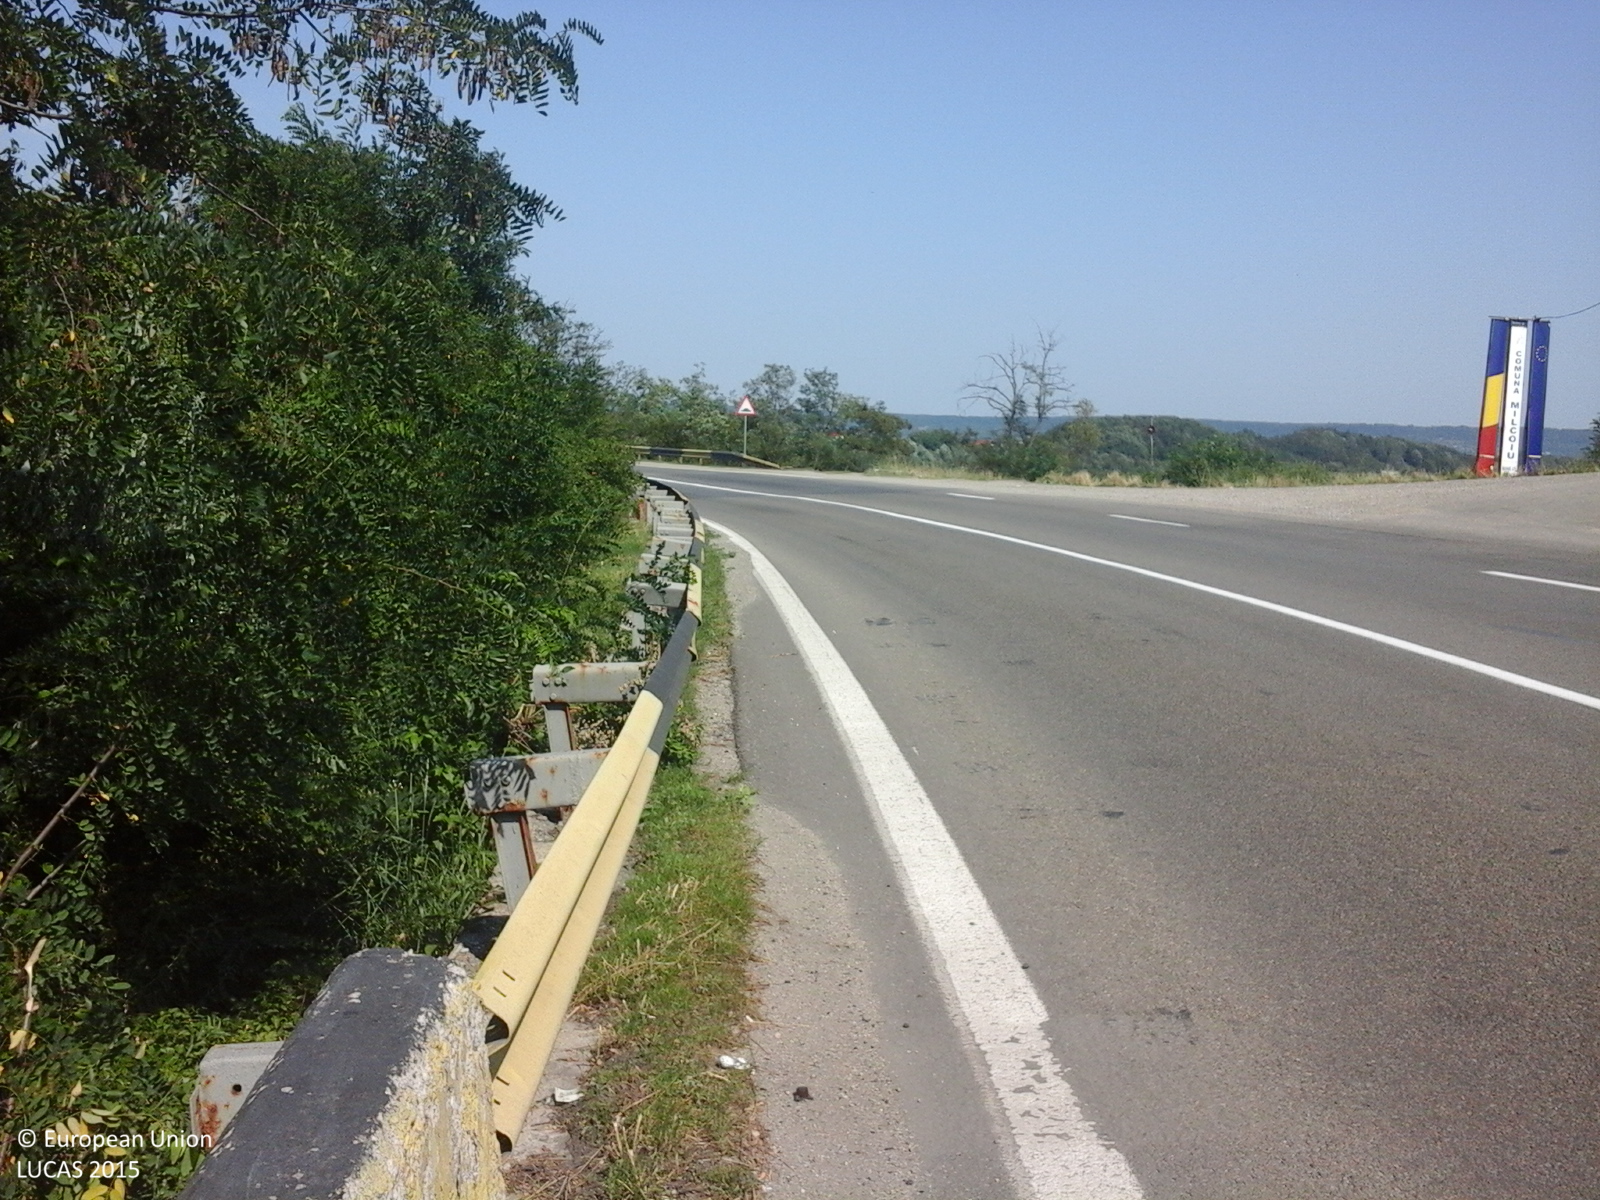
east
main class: Woodland
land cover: Broadleaved woodland
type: broadleaved evergreen forest
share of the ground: > 75 %
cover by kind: broadleaved forest trees 100 %
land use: Forestry
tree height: > 5 m
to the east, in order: Broadleaved woodland; Paved roads, cycling and walking lanes; Sand; Grass margins; Broadleaved woodland
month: July
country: RO
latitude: 45.0512
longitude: 24.4610
